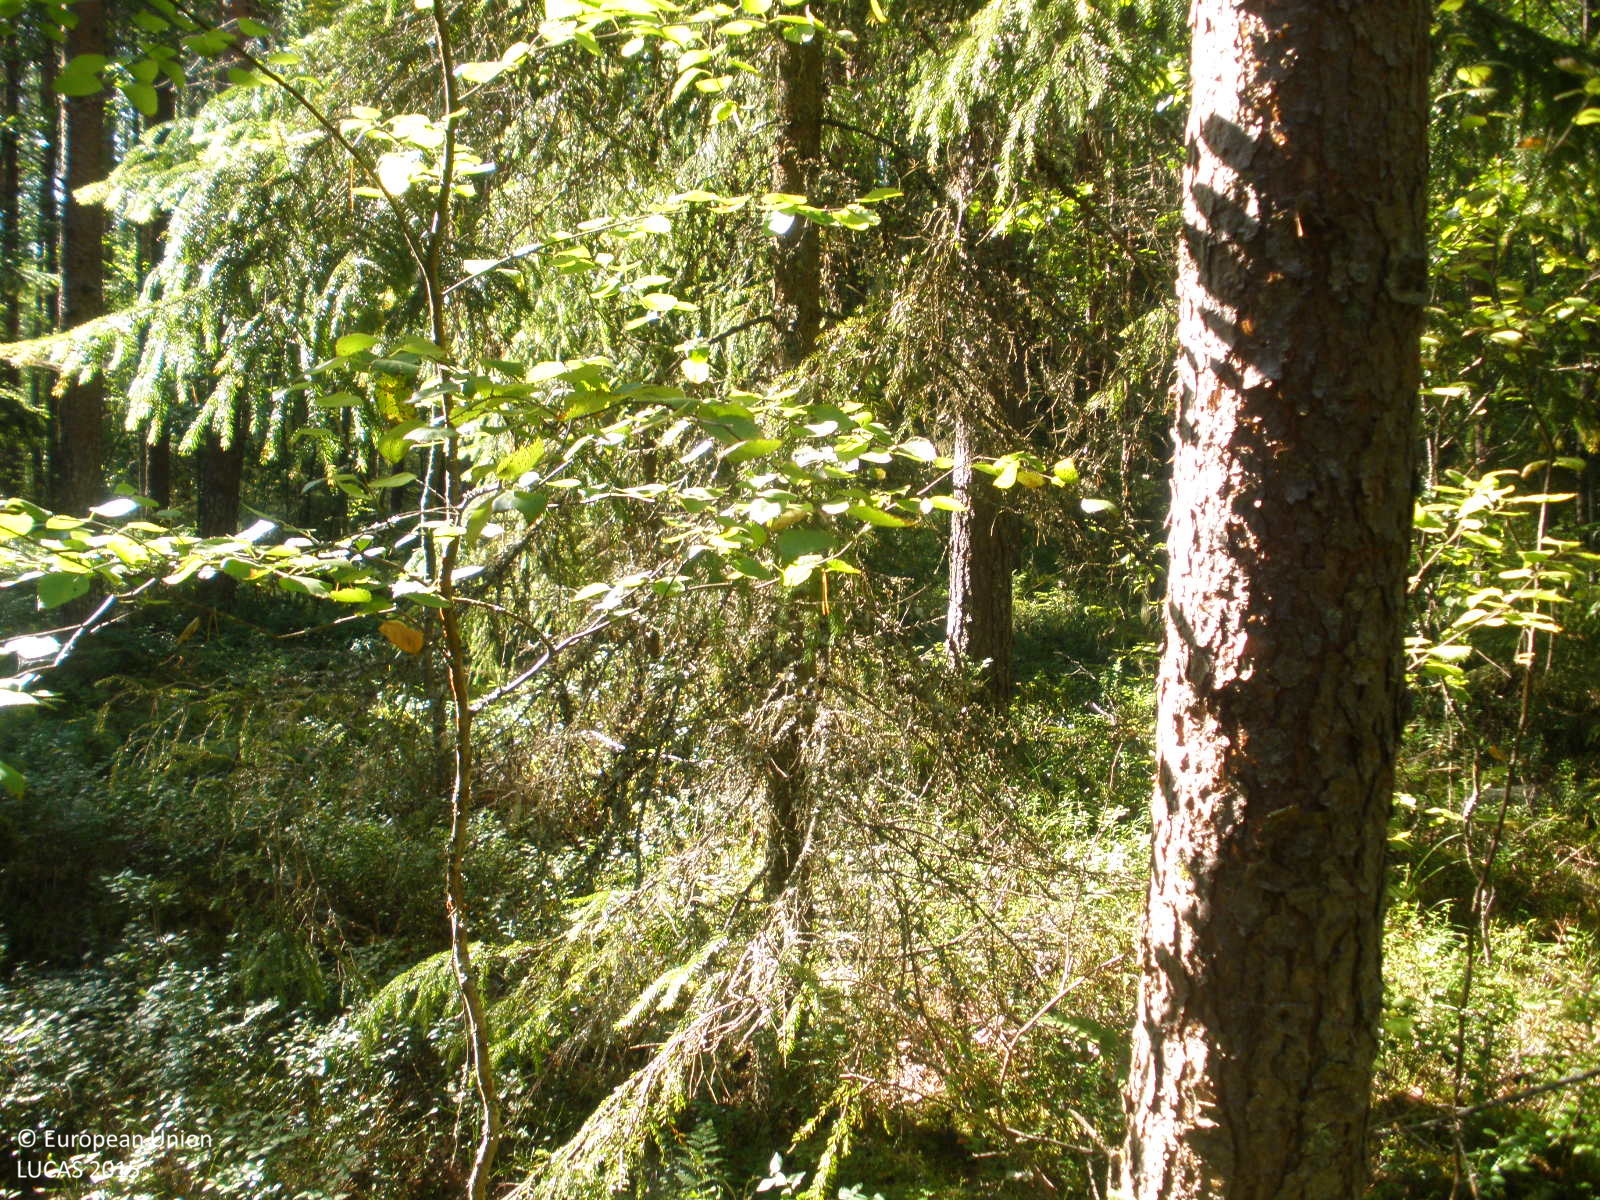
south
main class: Woodland
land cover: Pine dominated mixed woodland
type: boreal forest
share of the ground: > 75 %
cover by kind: coniferous forest trees 60 %, broadleaved forest trees 25 %, shrubs 5 %, herbaceous plants 5 %, lichens and mosses 5 %
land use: Forestry
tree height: > 5 m
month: August
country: FI
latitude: 60.9489
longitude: 24.8613
